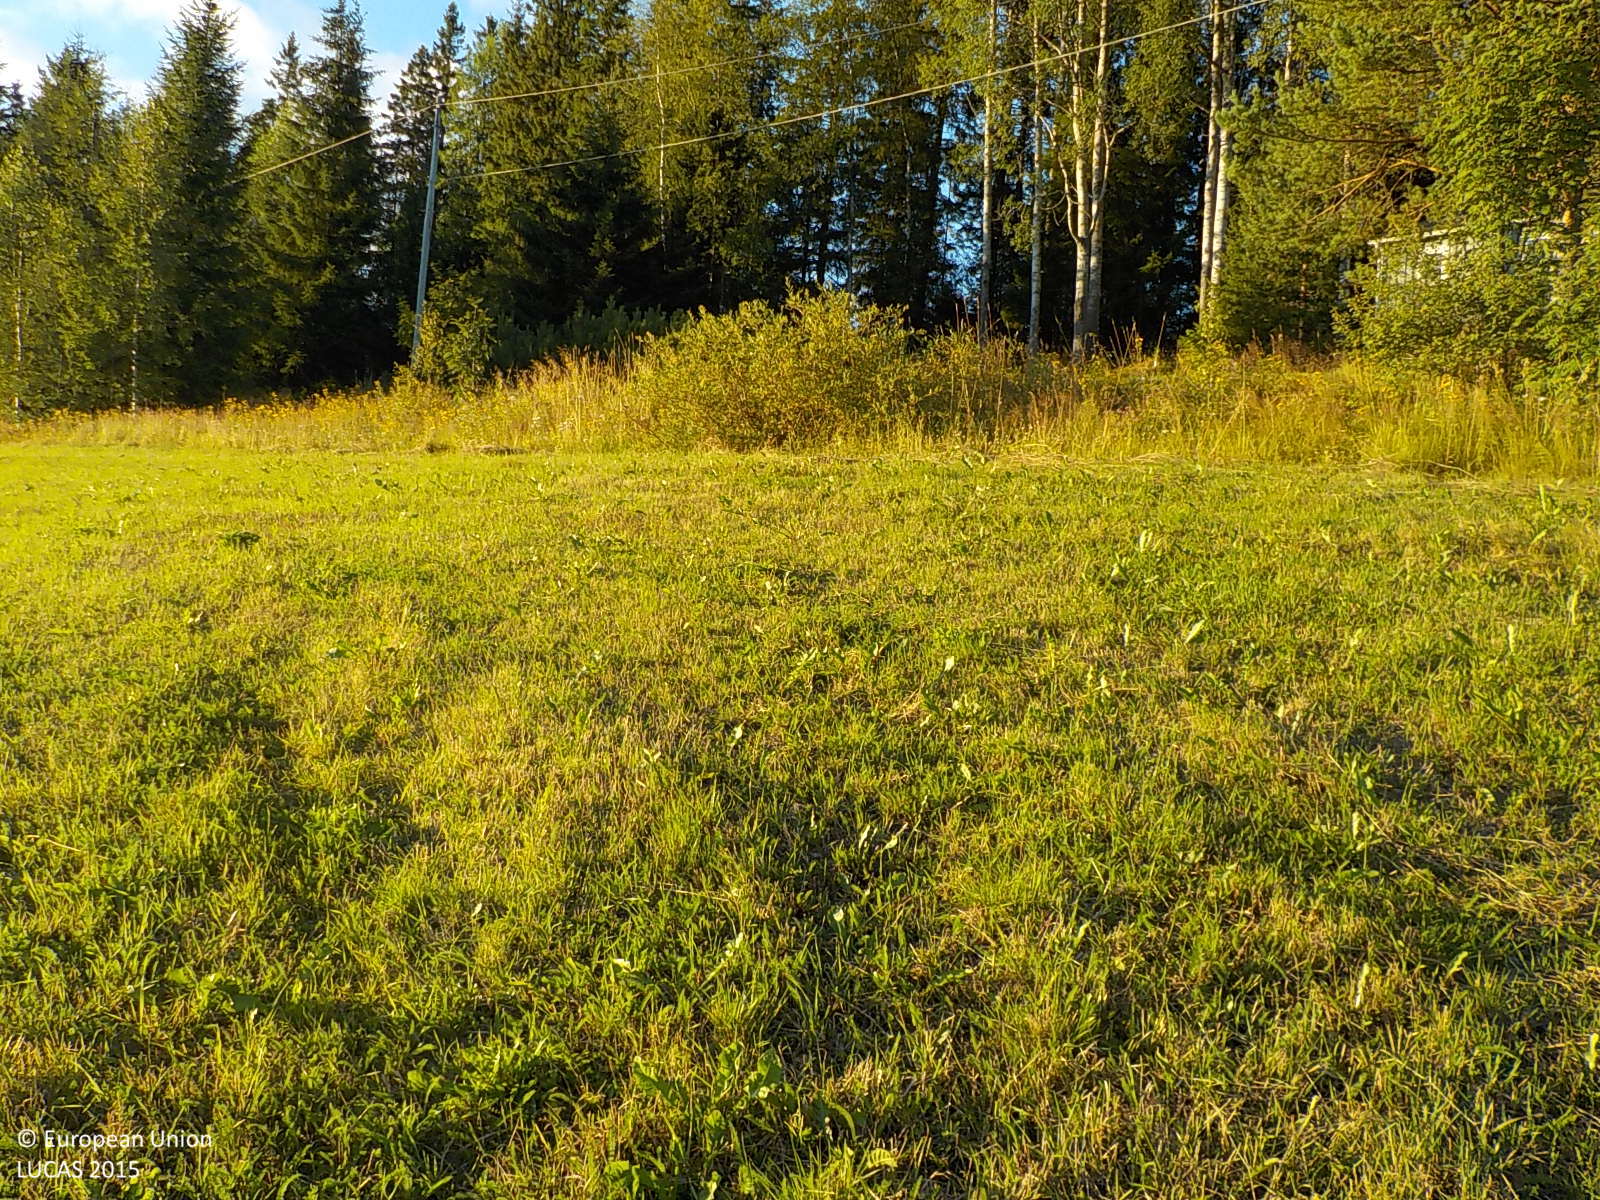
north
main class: Cropland
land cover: Other leguminous and mixtures for fodder
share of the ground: > 75 %
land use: Agriculture (excluding fallow land and kitchen gardens)
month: August
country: SE
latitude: 63.4457
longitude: 18.7792
